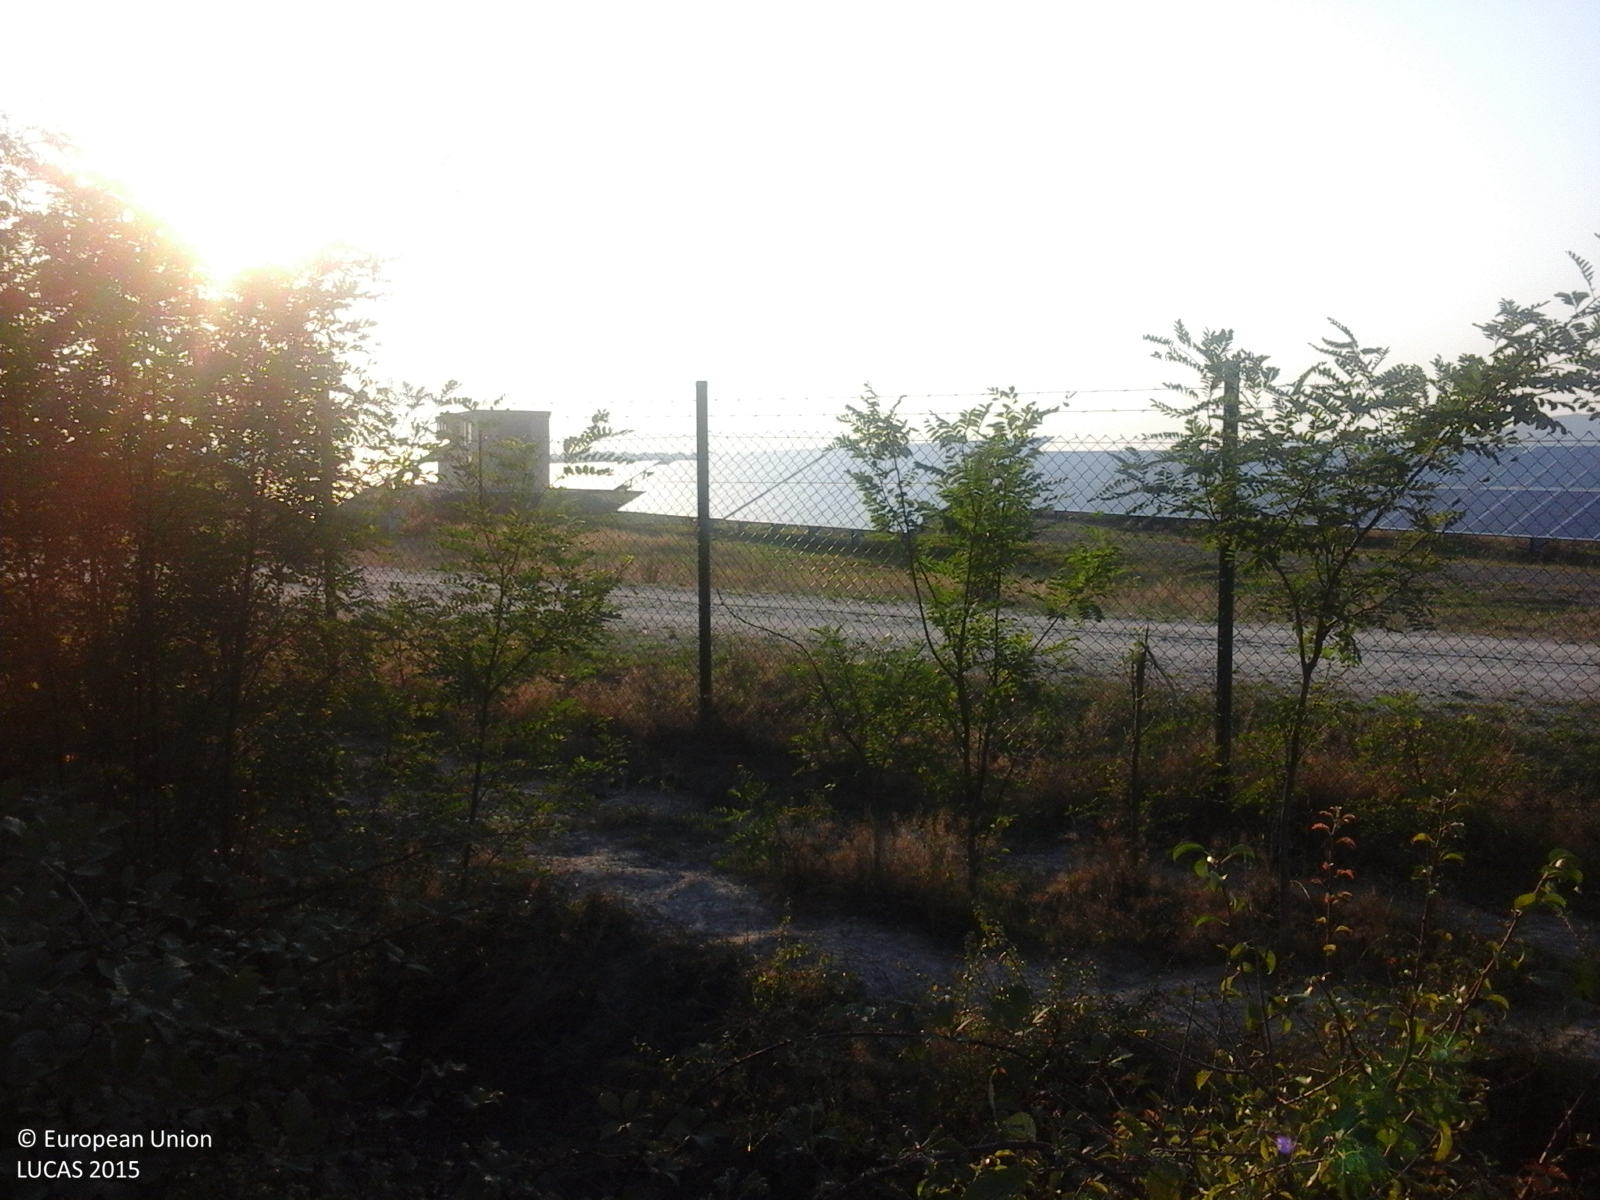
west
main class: Artificial land
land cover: Other artificial areas
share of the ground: > 75 %
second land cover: Grassland without tree/shrub cover
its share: > 75 %
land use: Energy production
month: August
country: RO
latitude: 46.4251
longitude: 22.1079
